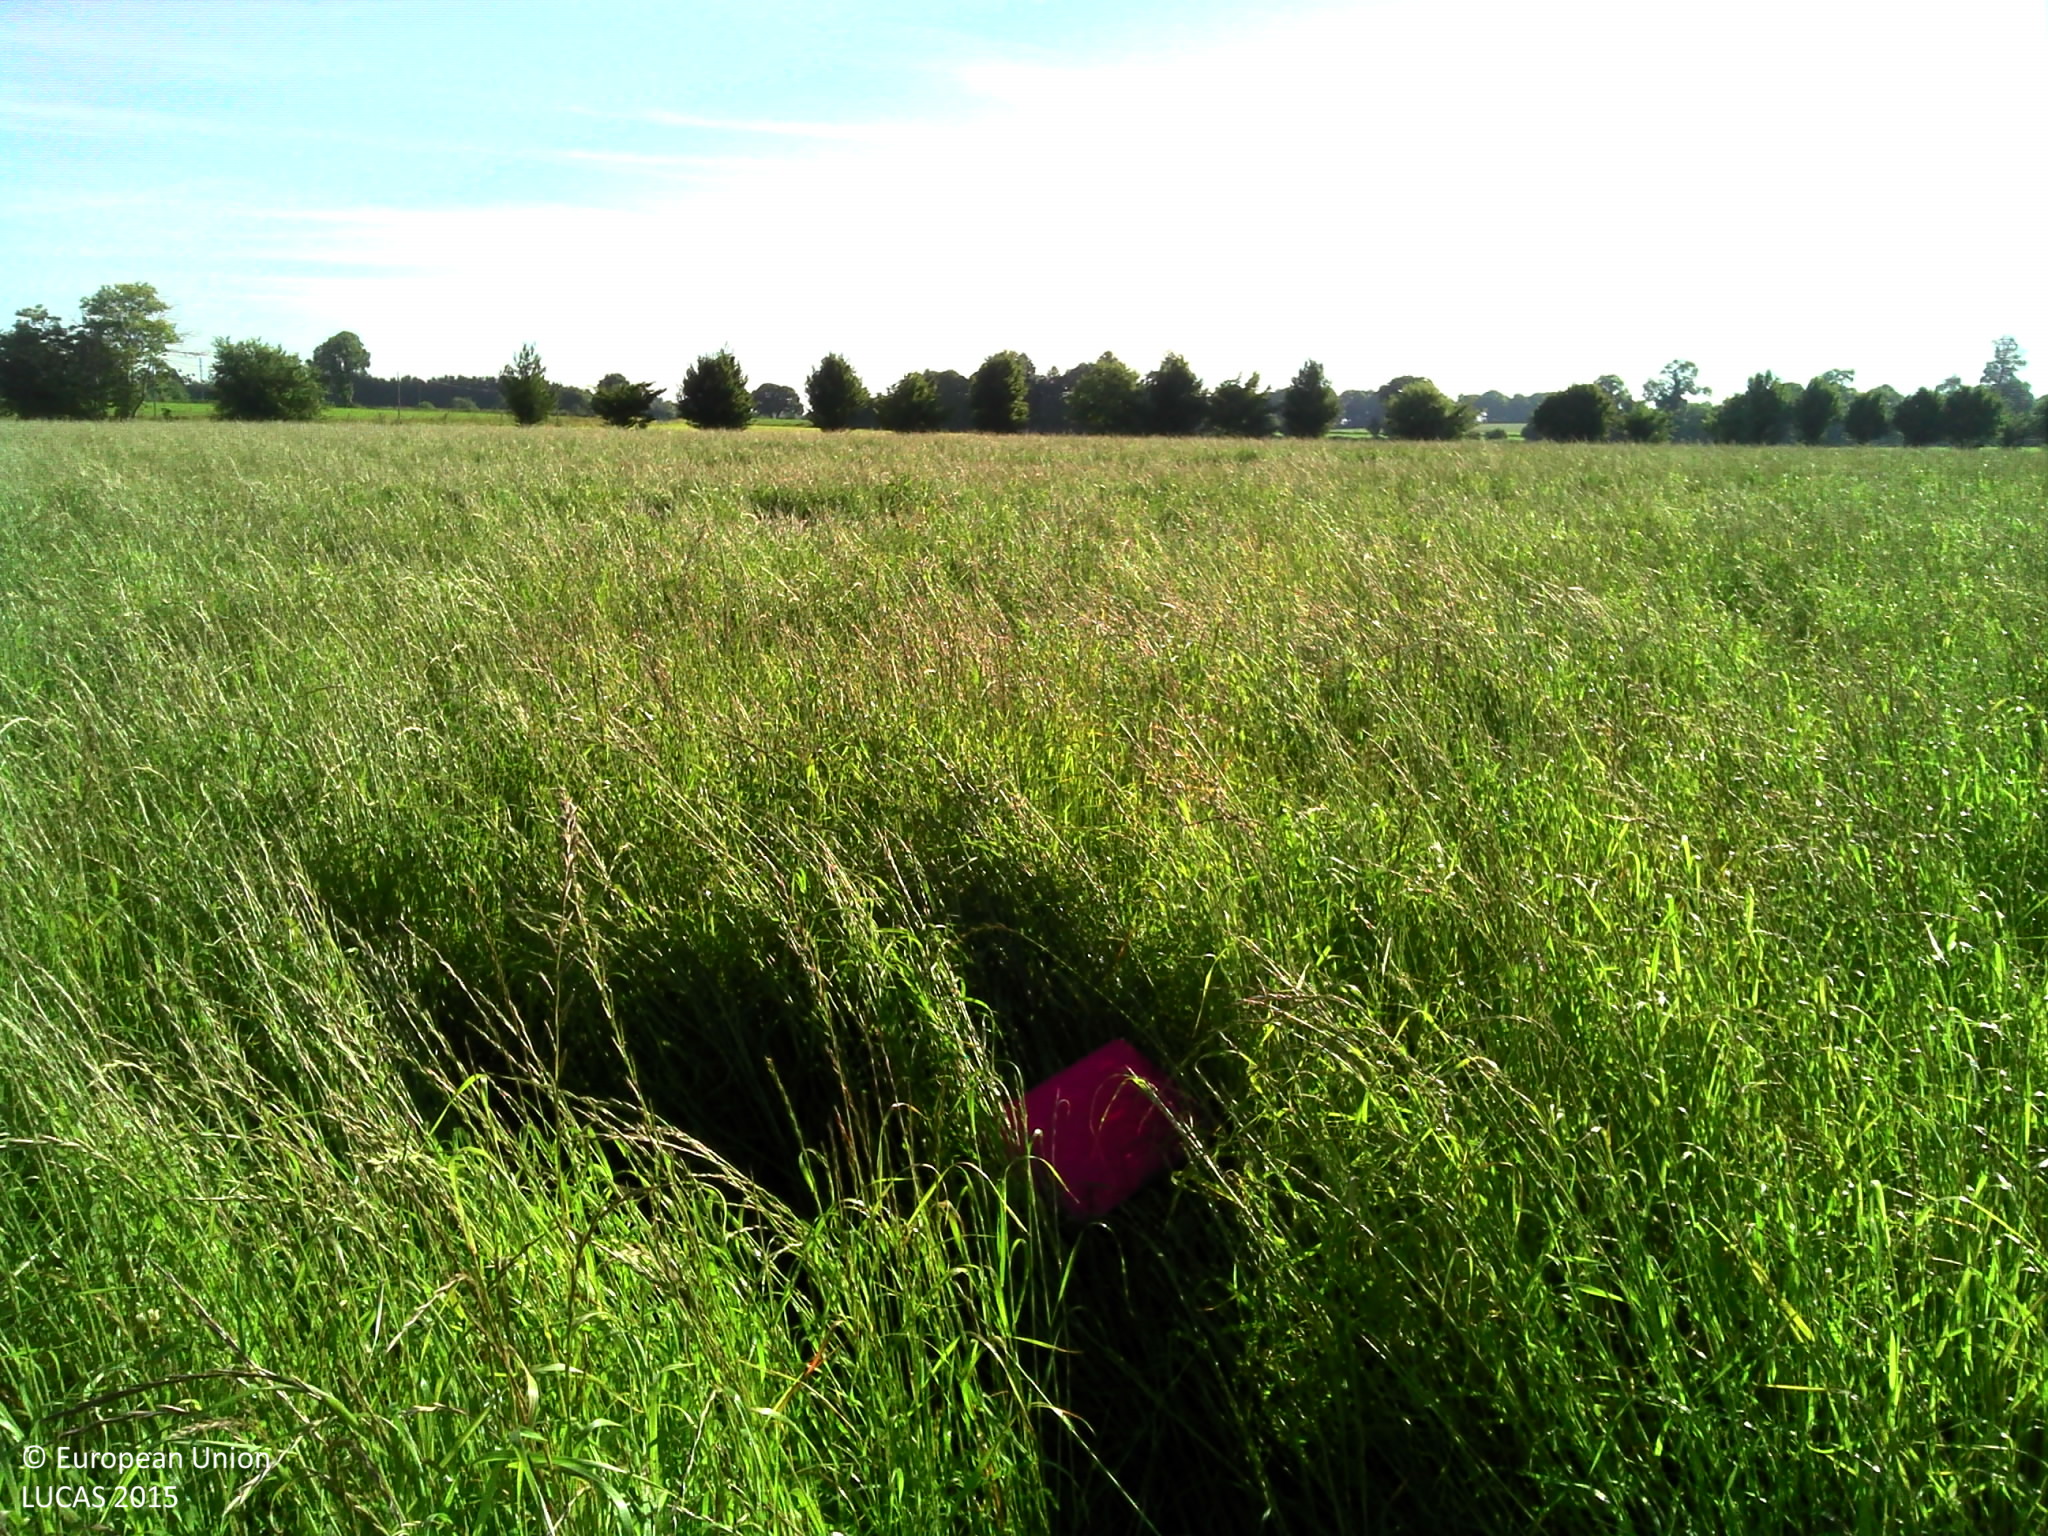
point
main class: Cropland
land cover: Temporary grasslands
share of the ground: > 75 %
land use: Agriculture (excluding fallow land and kitchen gardens)
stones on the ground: < 10 %
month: June
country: FR
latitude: 48.3711
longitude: -1.2616
